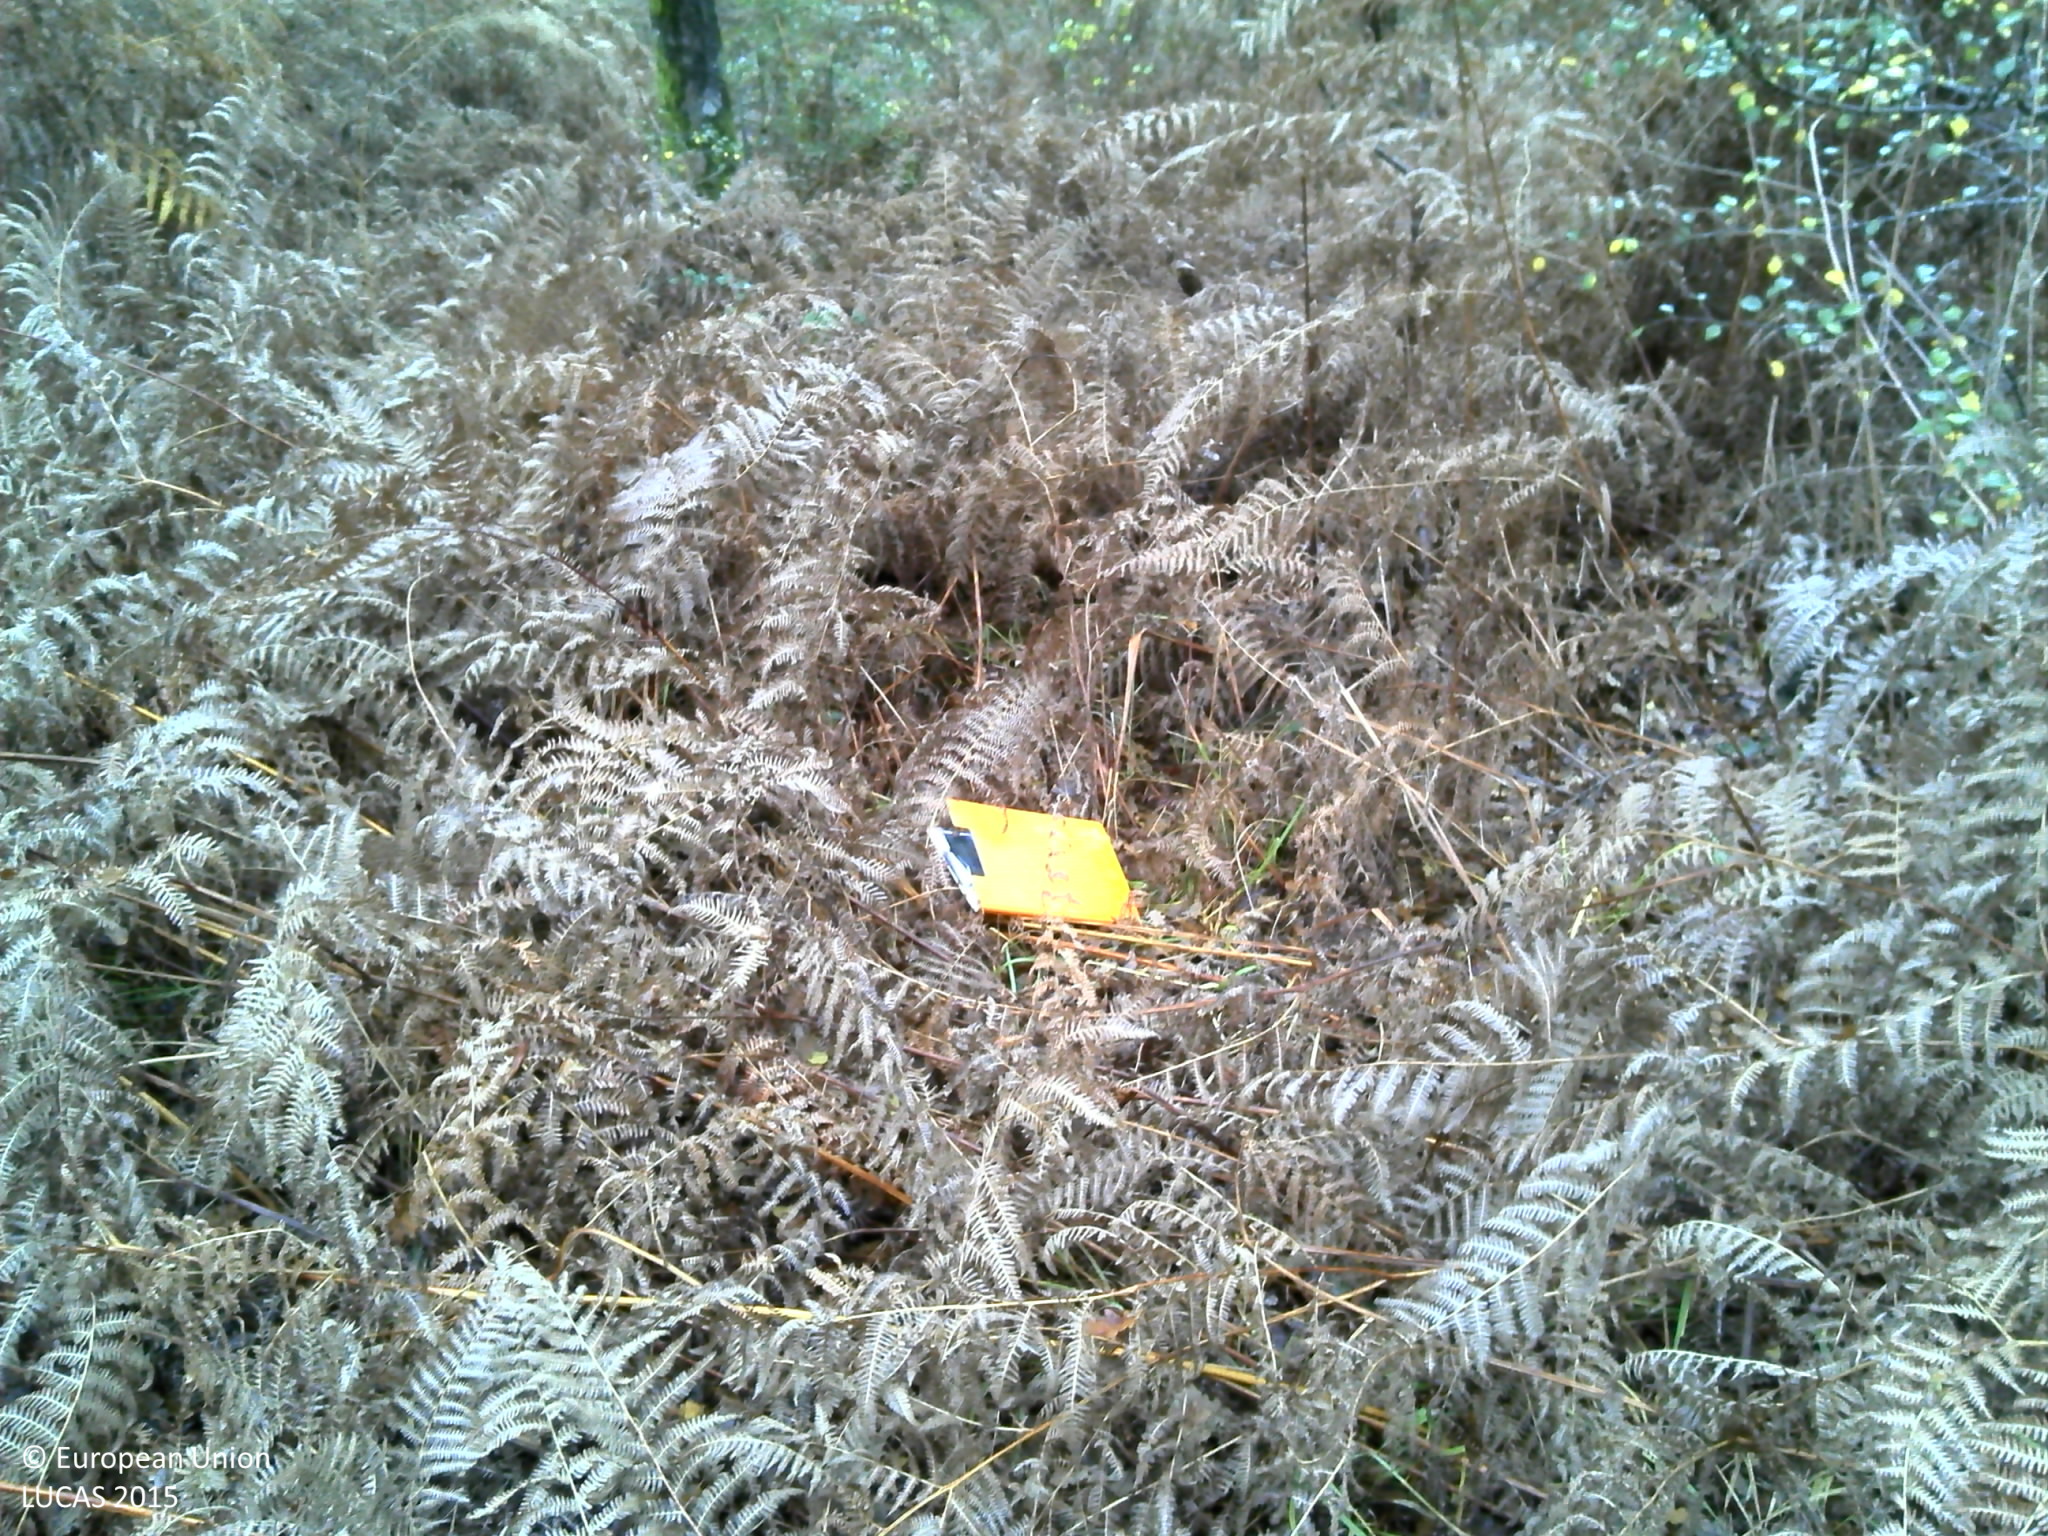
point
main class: Woodland
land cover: Broadleaved woodland
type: acidophilous oak and oak-birch forest
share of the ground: 50 - 75 %
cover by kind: broadleaved forest trees 70 %, herbaceous plants 30 %
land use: Forestry
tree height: > 5 m
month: November
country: FR
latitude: 47.6512
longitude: -1.3716
